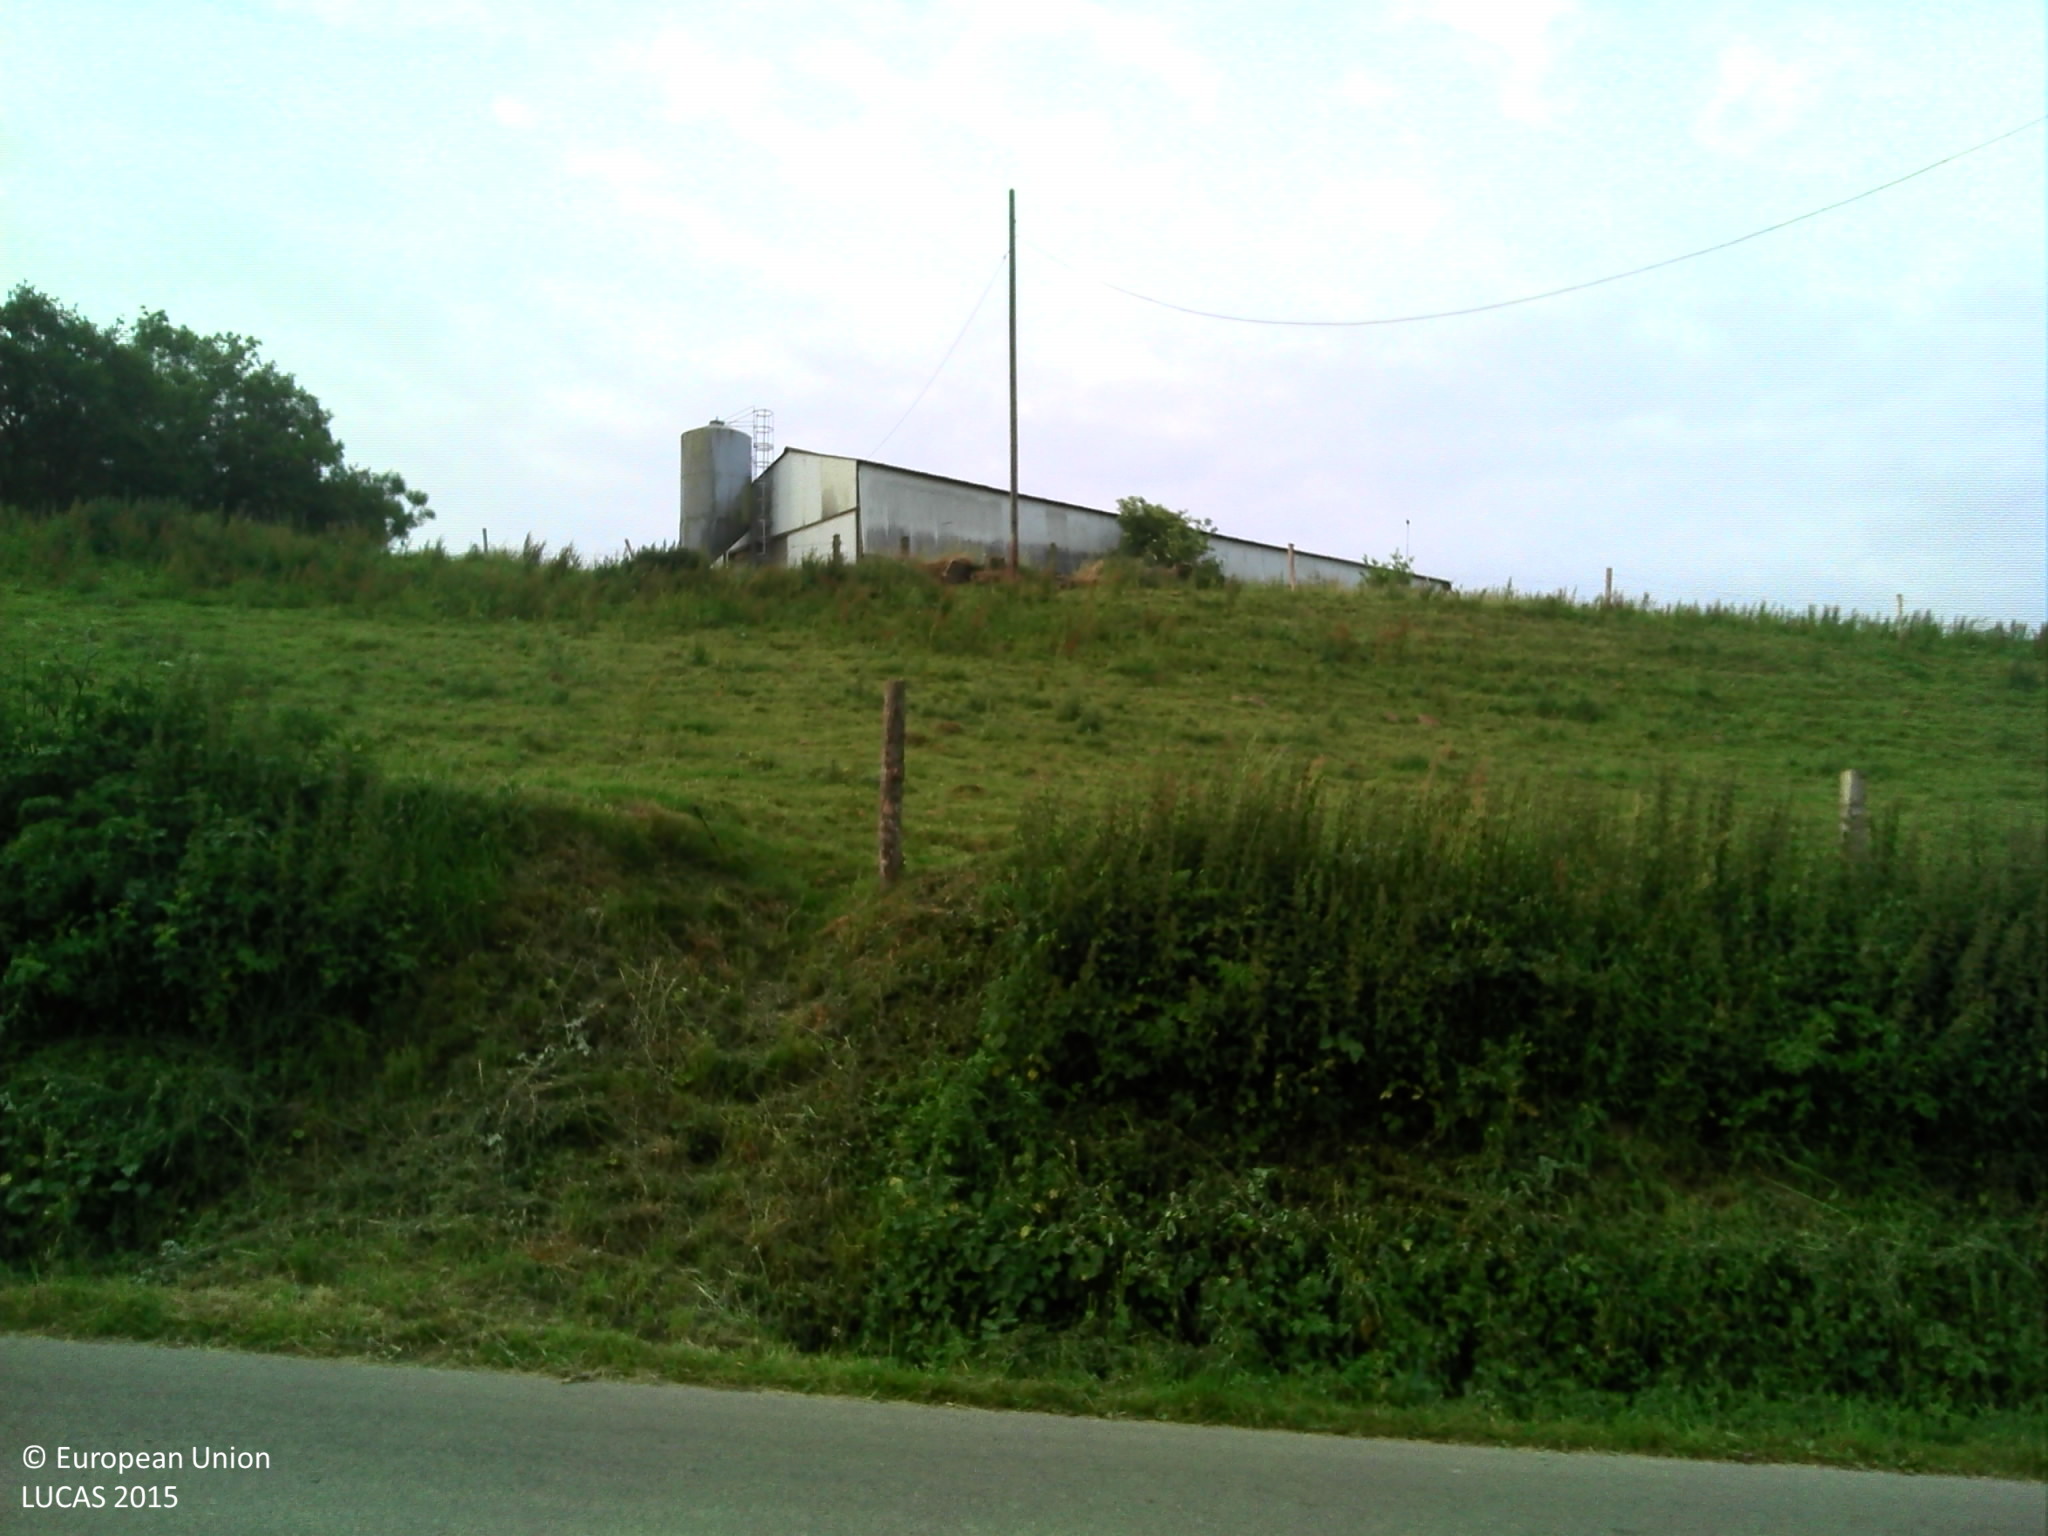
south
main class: Woodland
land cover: Broadleaved woodland
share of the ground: > 75 %
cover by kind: broadleaved forest trees 70 %, herbaceous plants 30 %
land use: Semi-natural and natural areas not in use
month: June
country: FR
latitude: 48.2515
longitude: -0.0631
